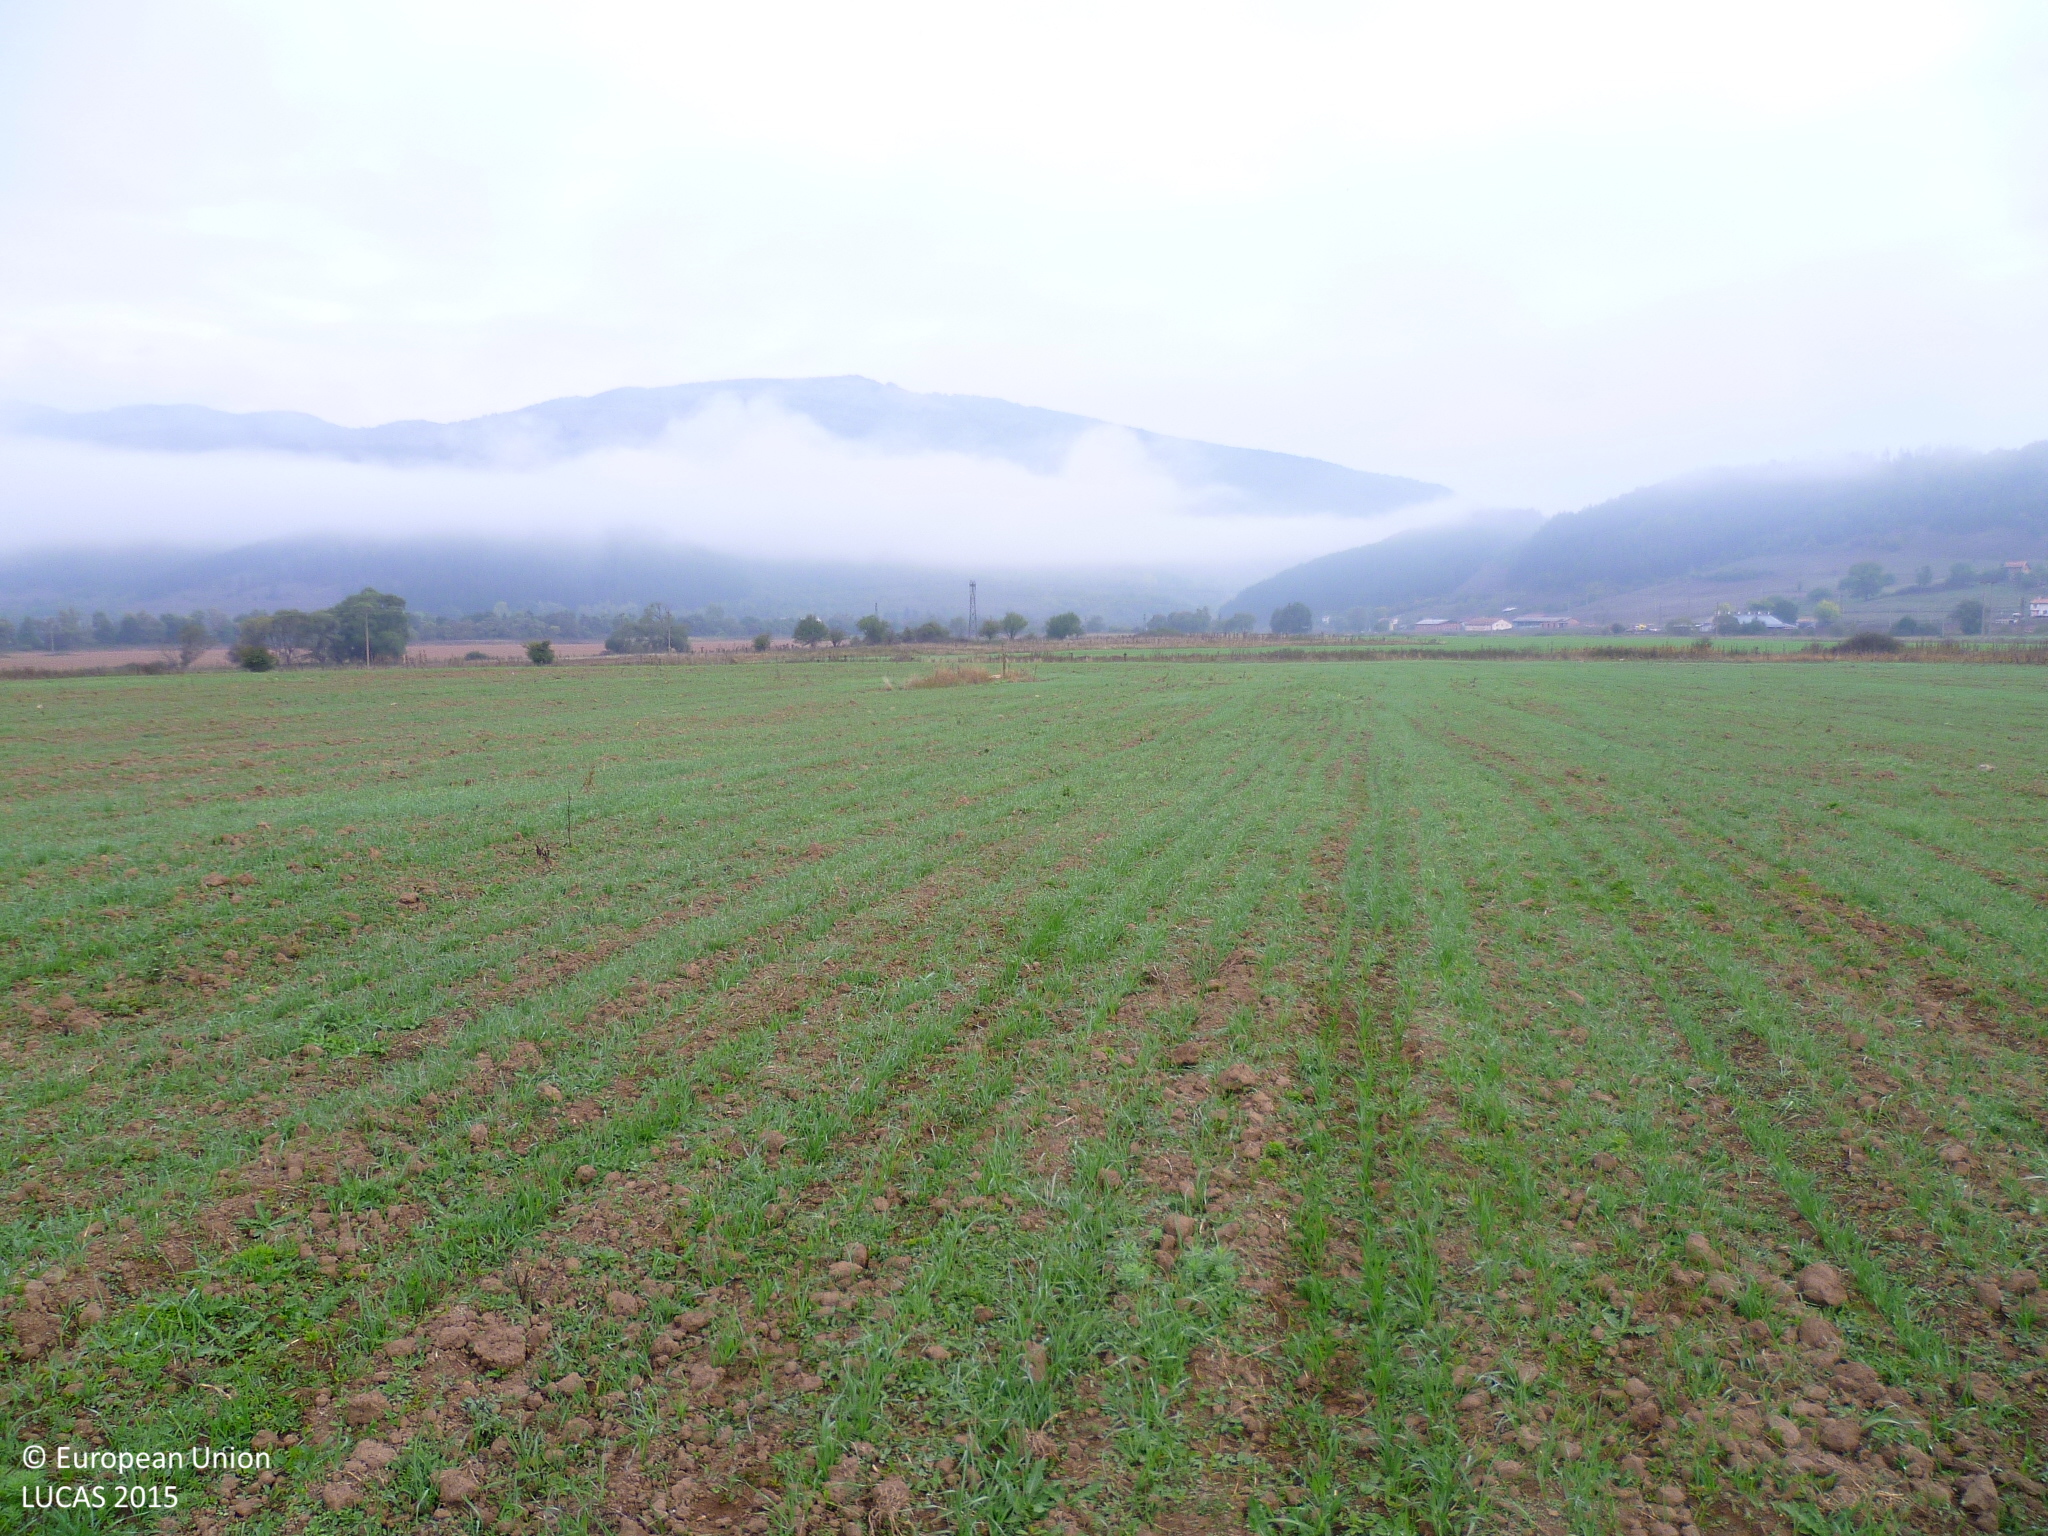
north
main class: Cropland
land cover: Common wheat
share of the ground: 25 - 50 %
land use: Agriculture (excluding fallow land and kitchen gardens)
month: October
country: BG
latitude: 42.8087
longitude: 22.6339
